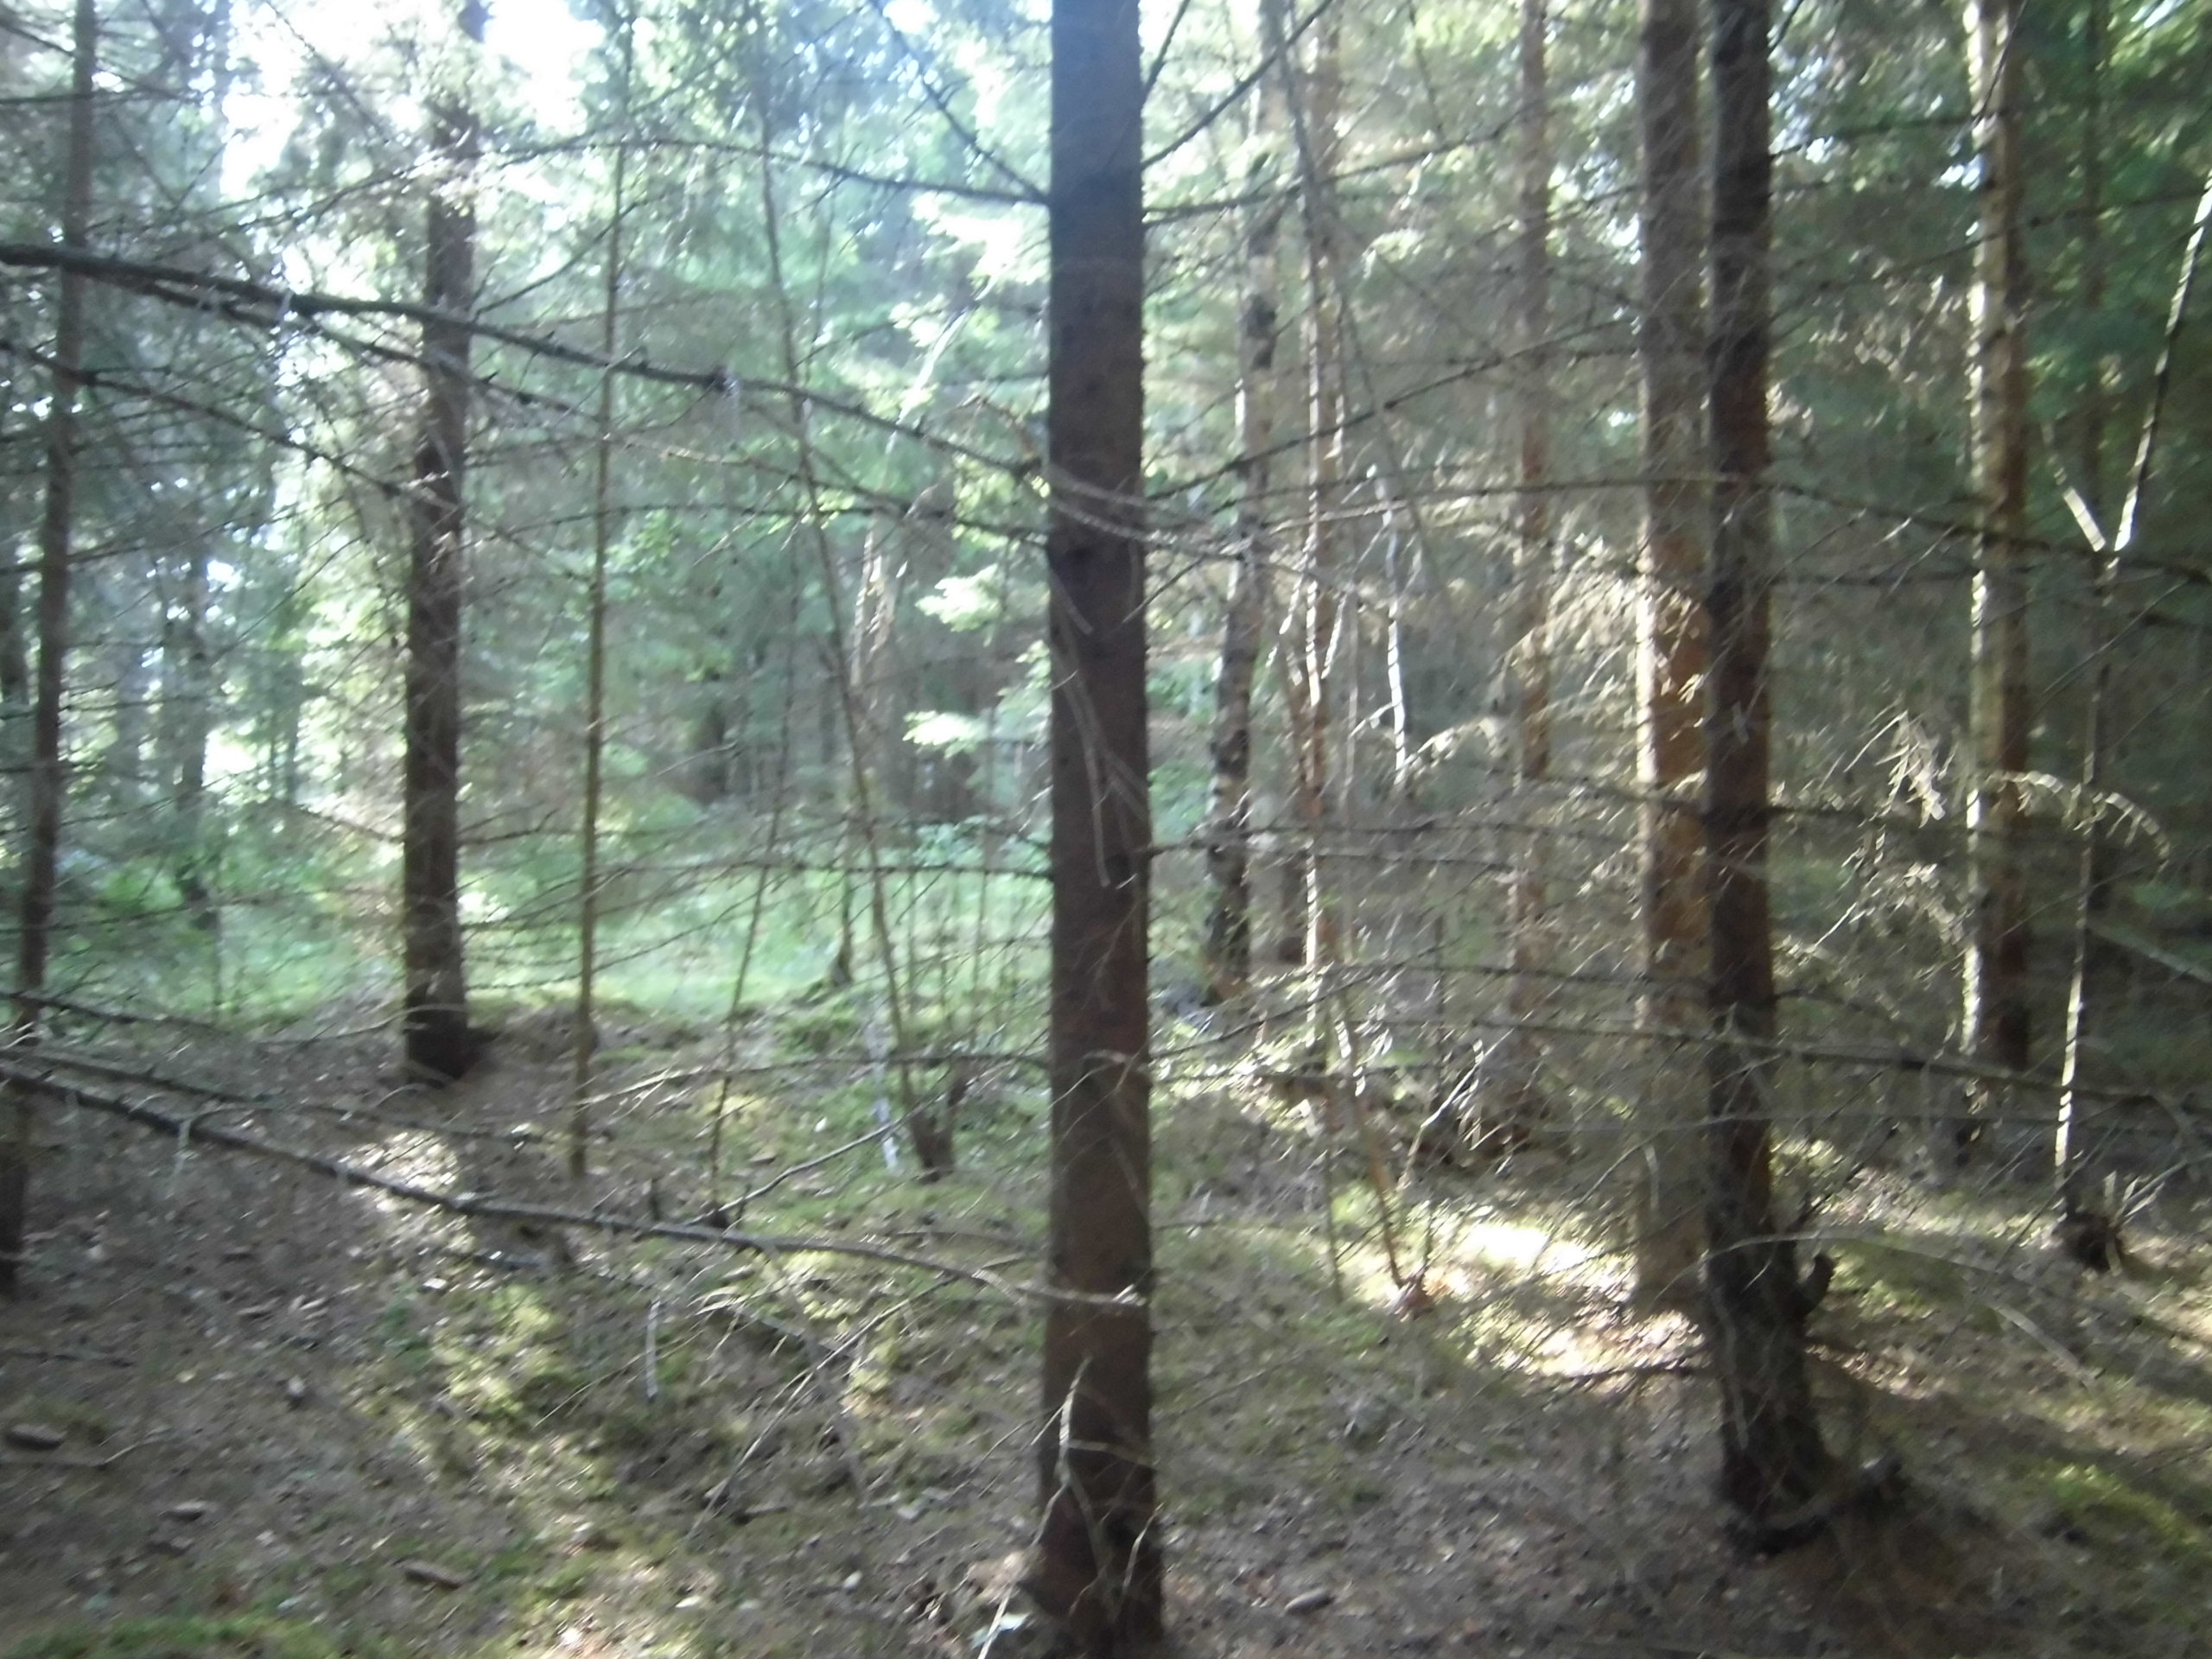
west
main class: Woodland
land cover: Spruce dominated coniferous woodland
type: boreal forest
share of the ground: > 75 %
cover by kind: coniferous forest trees 75 %, unconsolidated bare surface 15 %, herbaceous plants 5 %, lichens and mosses 5 %
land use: Forestry
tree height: > 5 m
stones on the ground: 10 - 25 %
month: July
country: SE
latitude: 57.4170
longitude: 15.1745
